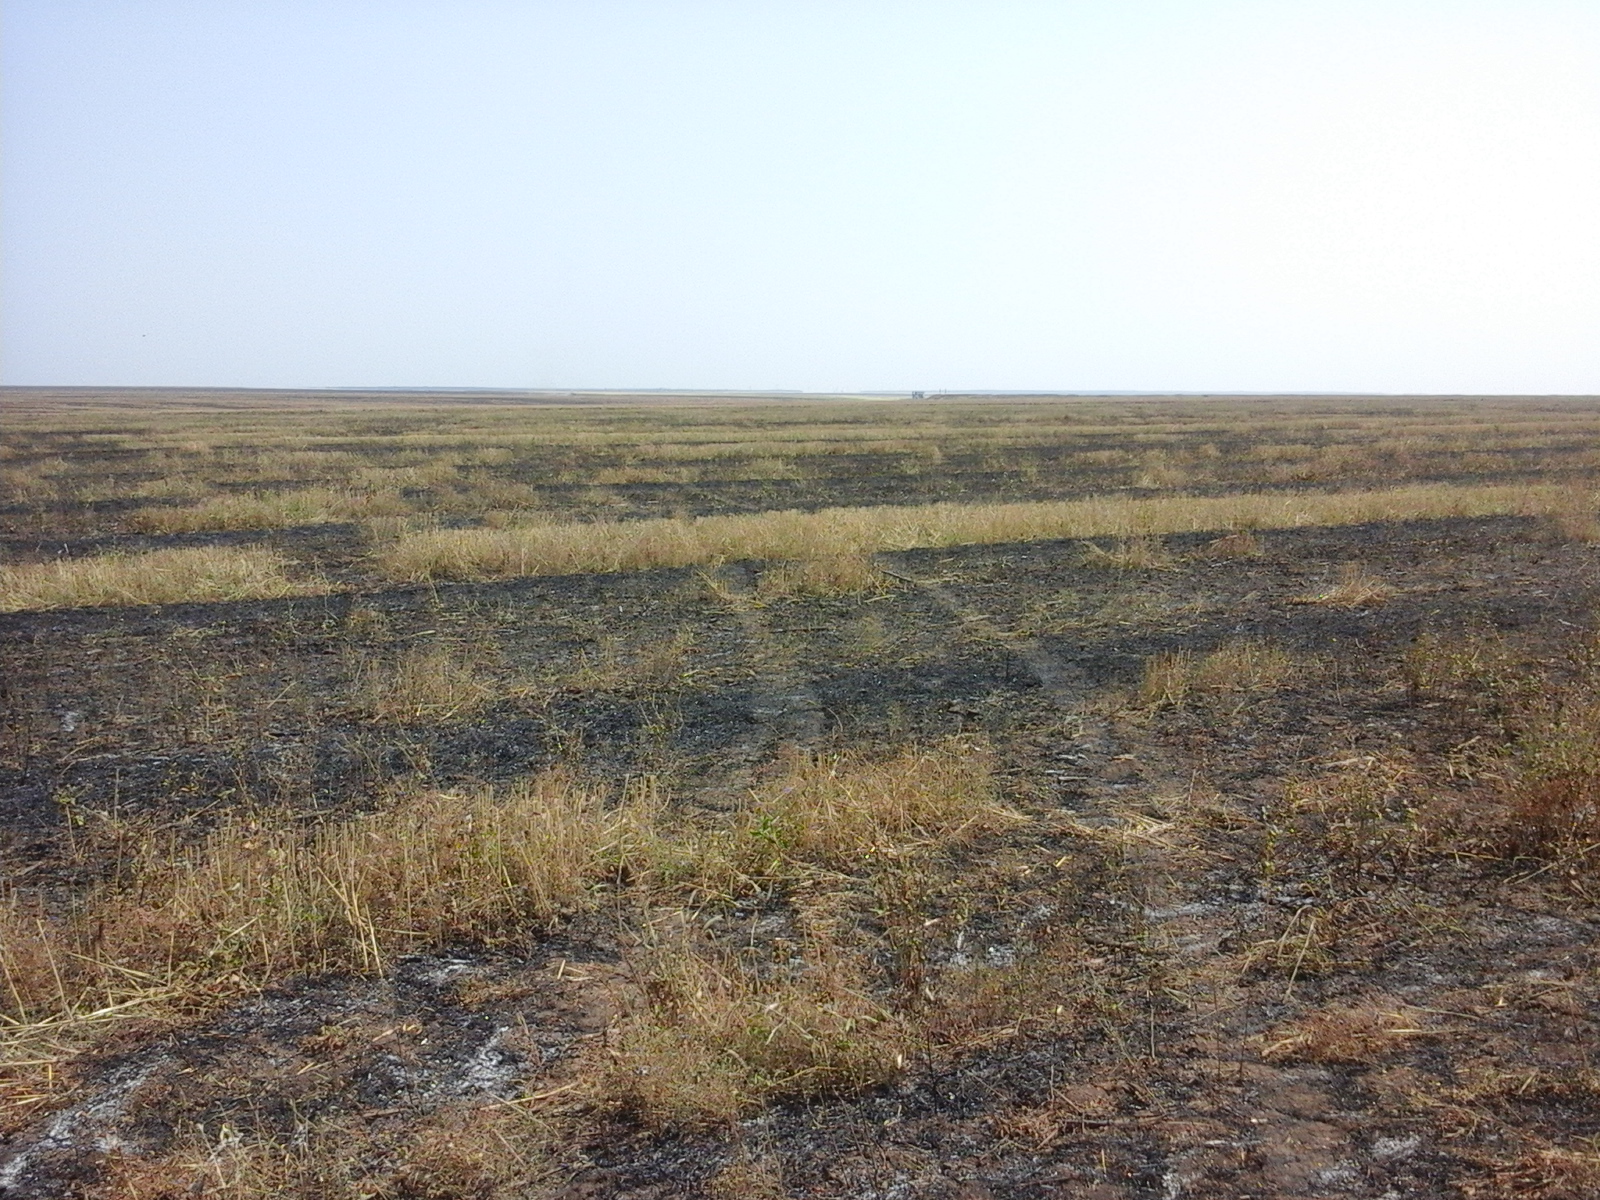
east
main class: Cropland
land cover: Common wheat
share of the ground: 25 - 50 %
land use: Agriculture (excluding fallow land and kitchen gardens)
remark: Burnt area
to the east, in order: Common wheat
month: August
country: RO
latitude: 44.1895
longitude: 23.3981
